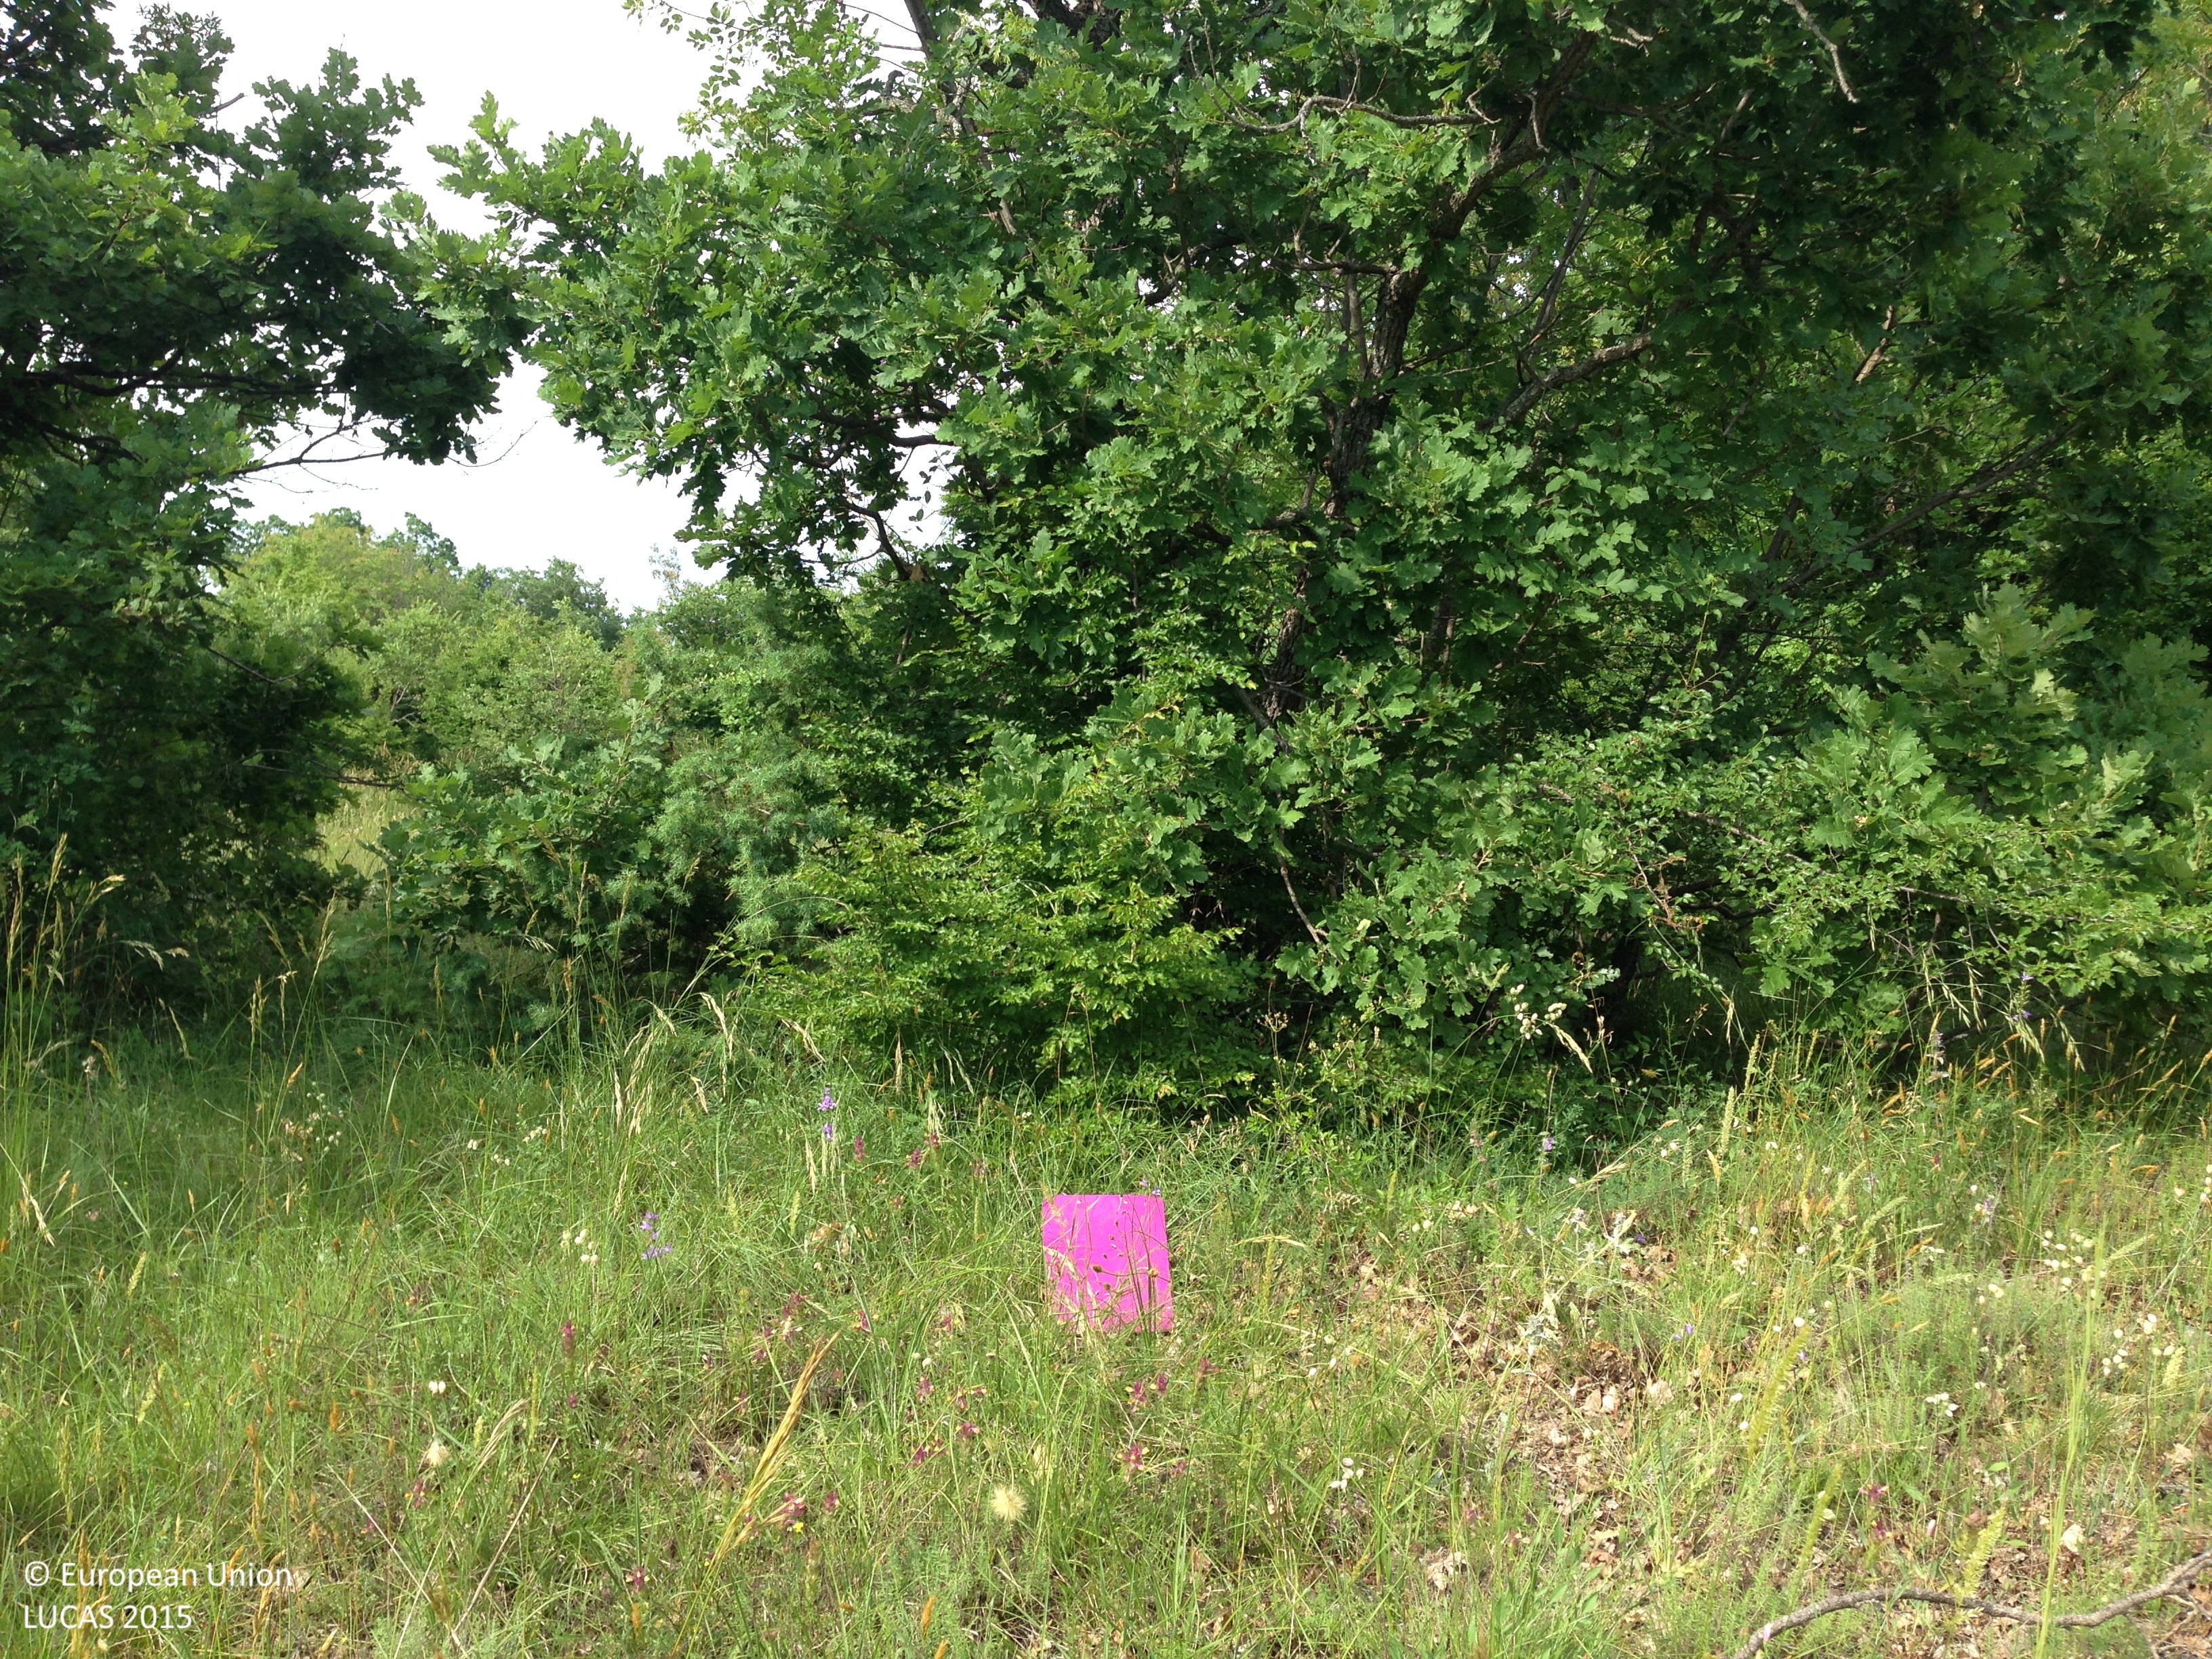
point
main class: Woodland
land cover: Broadleaved woodland
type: thermophilous deciduous forest
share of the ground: 25 - 50 %
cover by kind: herbaceous plants 40 %, broadleaved forest trees 35 %, shrubs 10 %, unconsolidated bare surface 10 %, consolidated bare surface 5 %
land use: Semi-natural and natural areas not in use
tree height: > 5 m
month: June
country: HR
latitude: 43.7377
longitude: 16.3860
